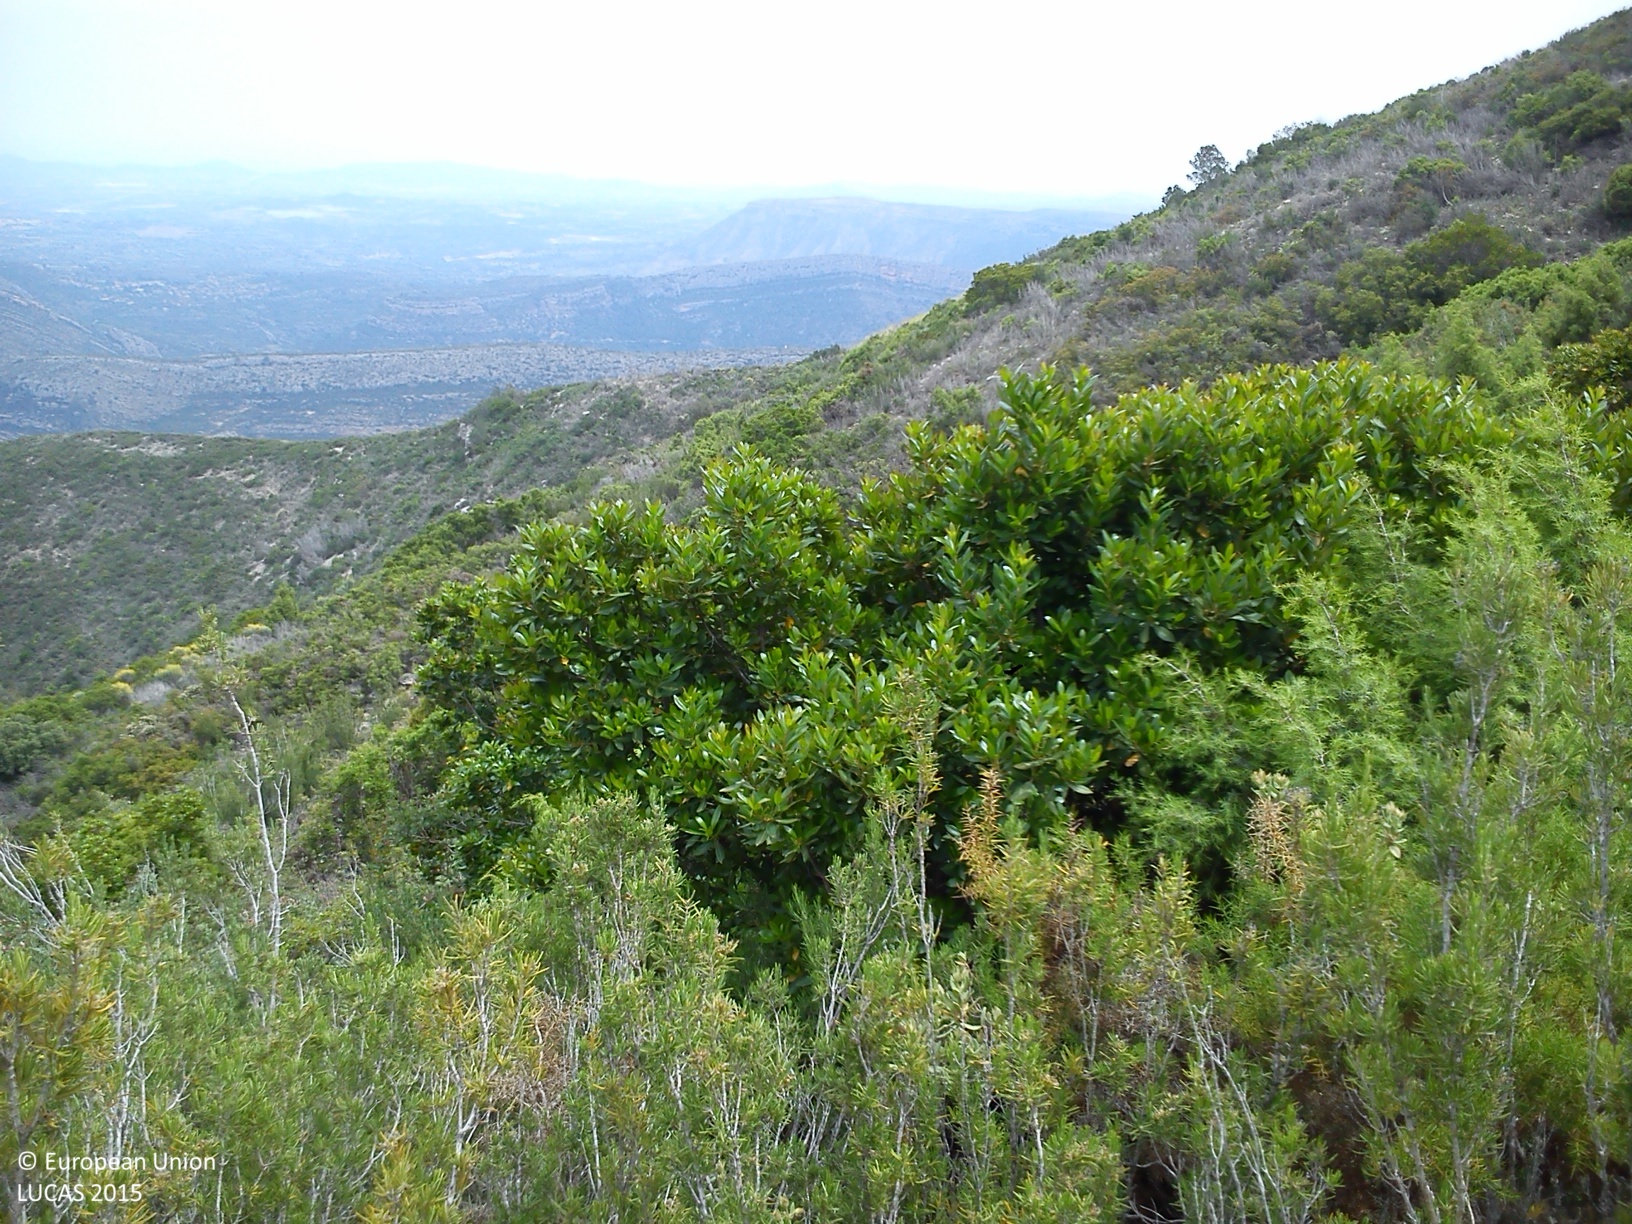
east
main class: Shrubland
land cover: Shrubland without tree cover
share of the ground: > 75 %
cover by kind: shrubs 80 %, herbaceous plants 10 %, consolidated bare surface 10 %
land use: Semi-natural and natural areas not in use
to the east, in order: Shrubland without tree cover; Shrubland with sparse tree cover; Shrubland without tree cover
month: May
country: ES
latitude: 39.6709
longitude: -0.9488
